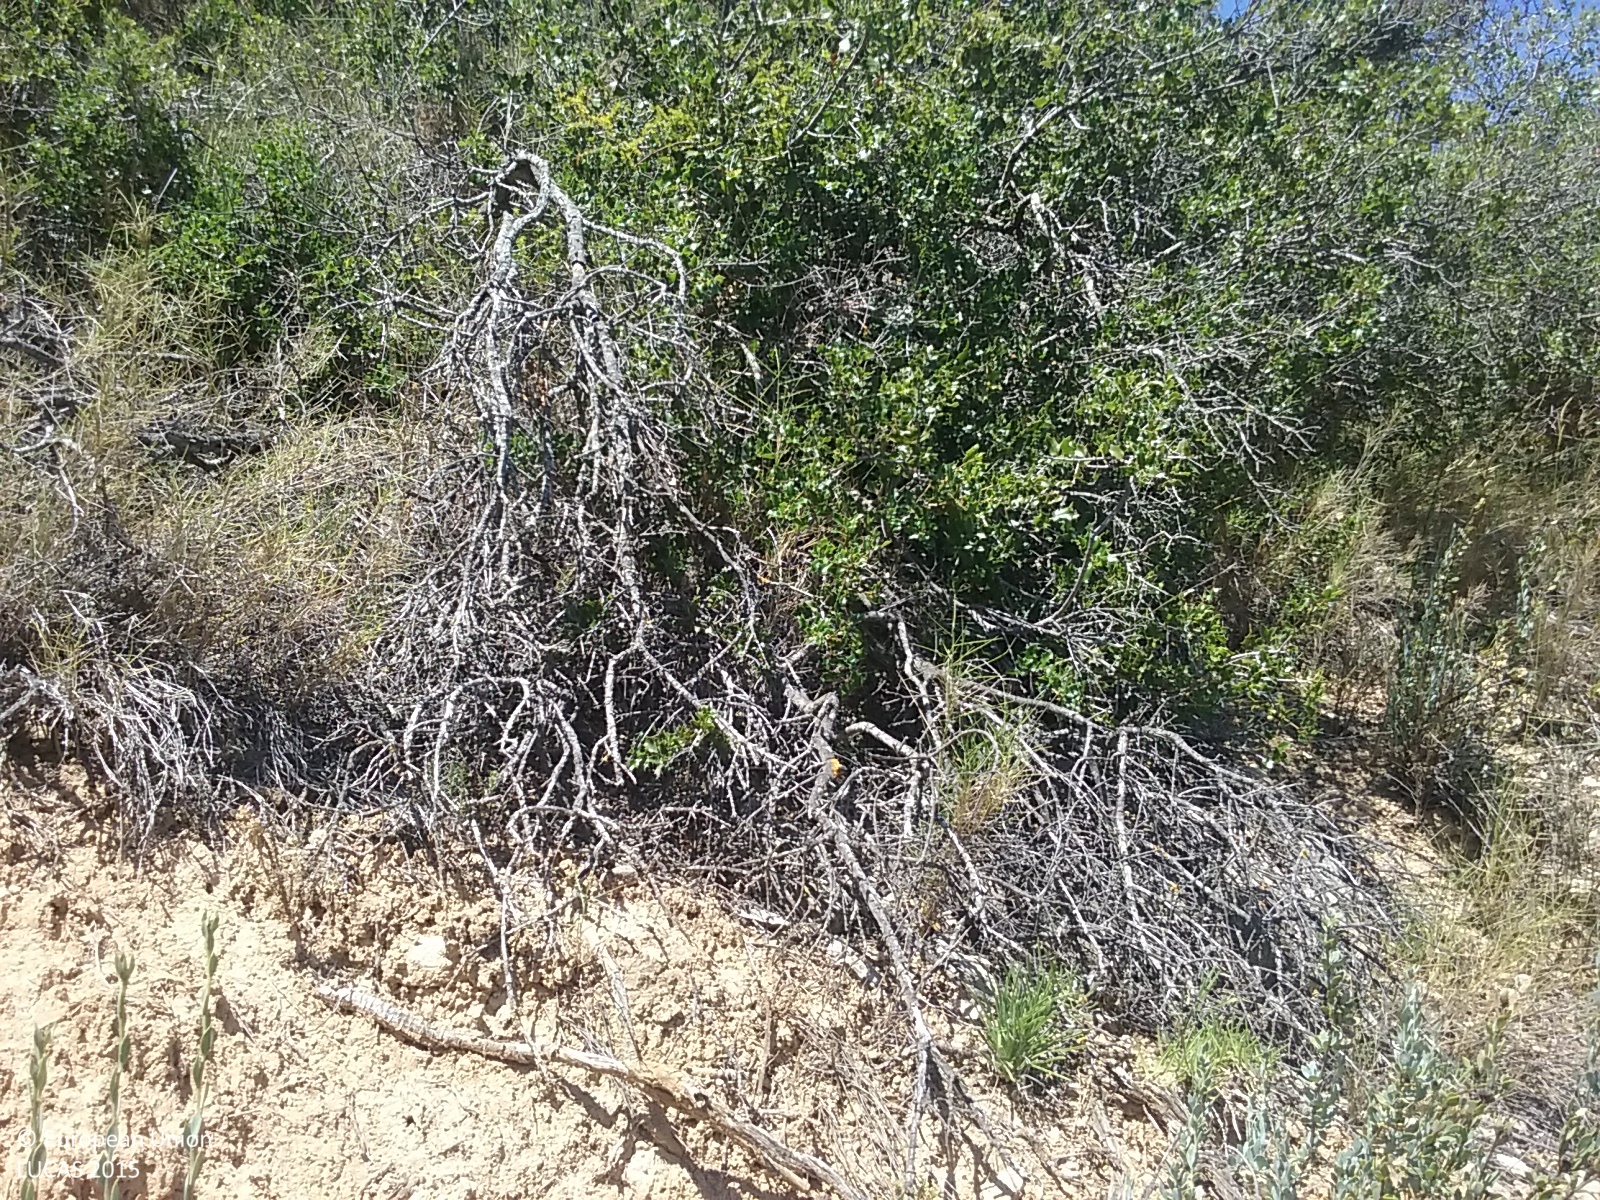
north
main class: Woodland
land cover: Pine dominated coniferous woodland
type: coniferous forest of the mediterranean region
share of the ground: 10 - 25 %
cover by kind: shrubs 75 %, coniferous forest trees 25 %
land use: Semi-natural and natural areas not in use
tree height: > 5 m
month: June
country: ES
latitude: 41.3128
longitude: 0.4691
